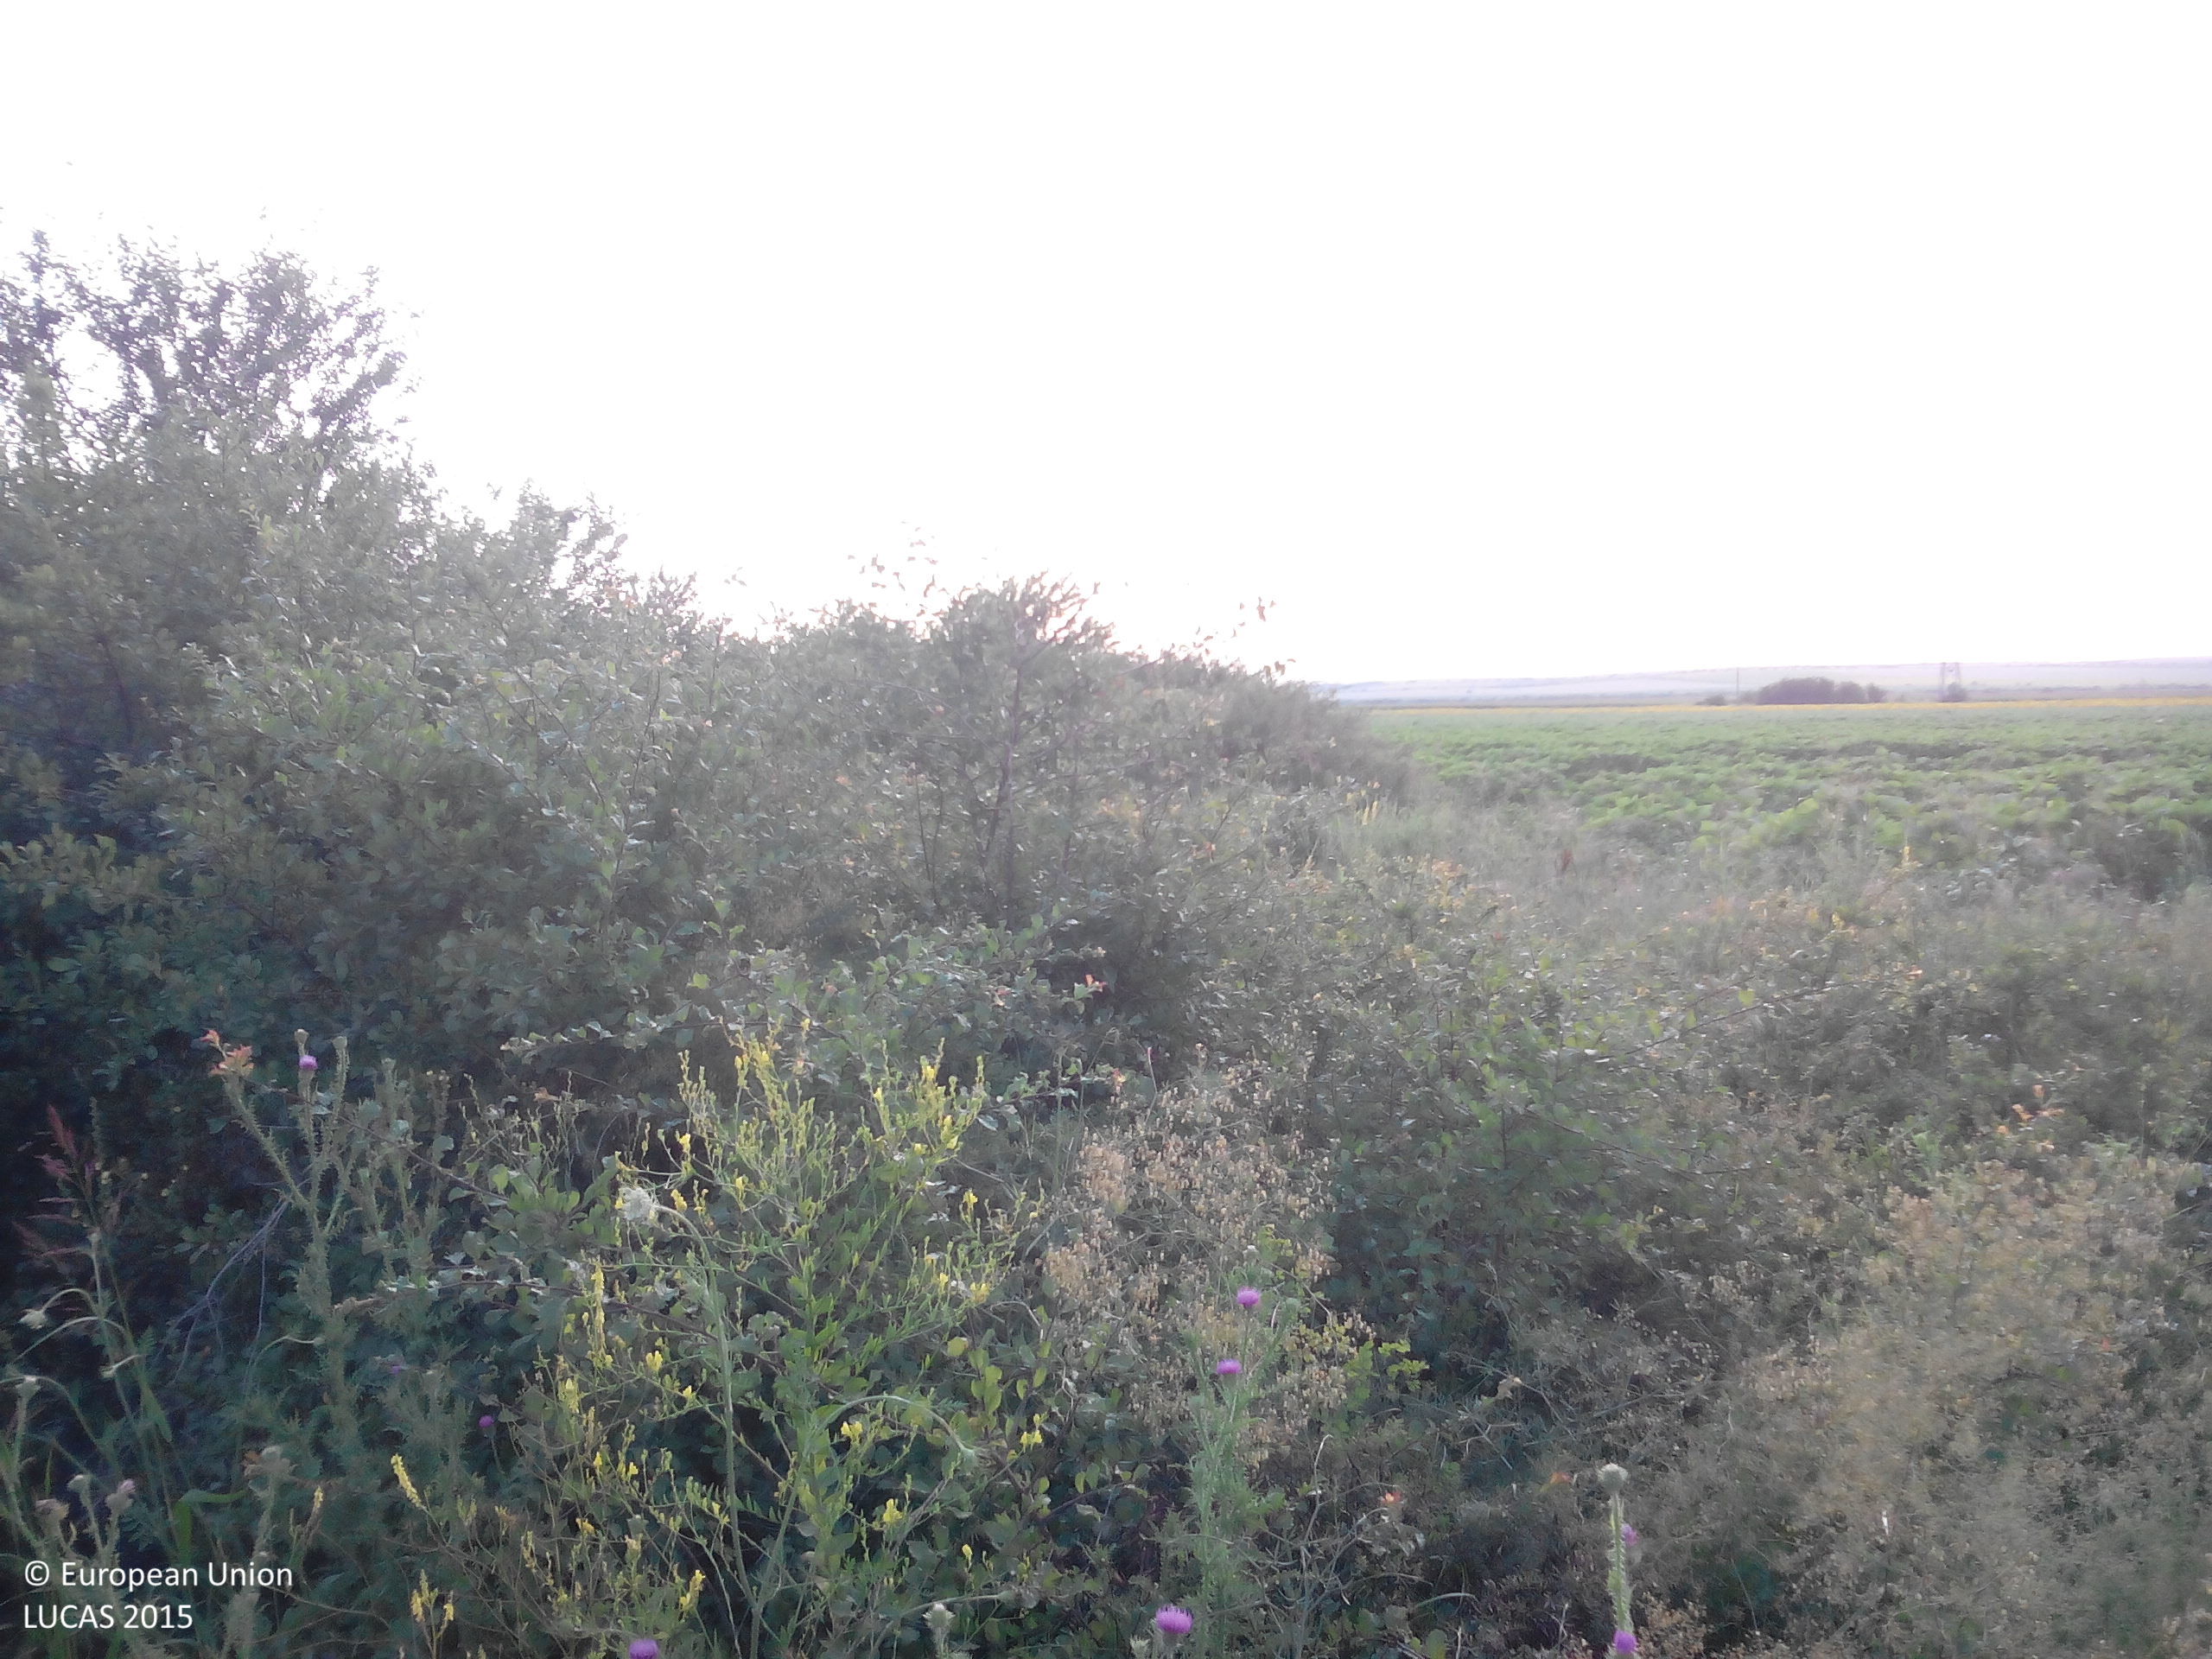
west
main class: Shrubland
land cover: Shrubland with sparse tree cover
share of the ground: > 75 %
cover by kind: shrubs 90 %, broadleaved forest trees 5 %, herbaceous plants 5 %
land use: Abandoned areas
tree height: < 5 m
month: July
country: BG
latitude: 43.3451
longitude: 24.1037
